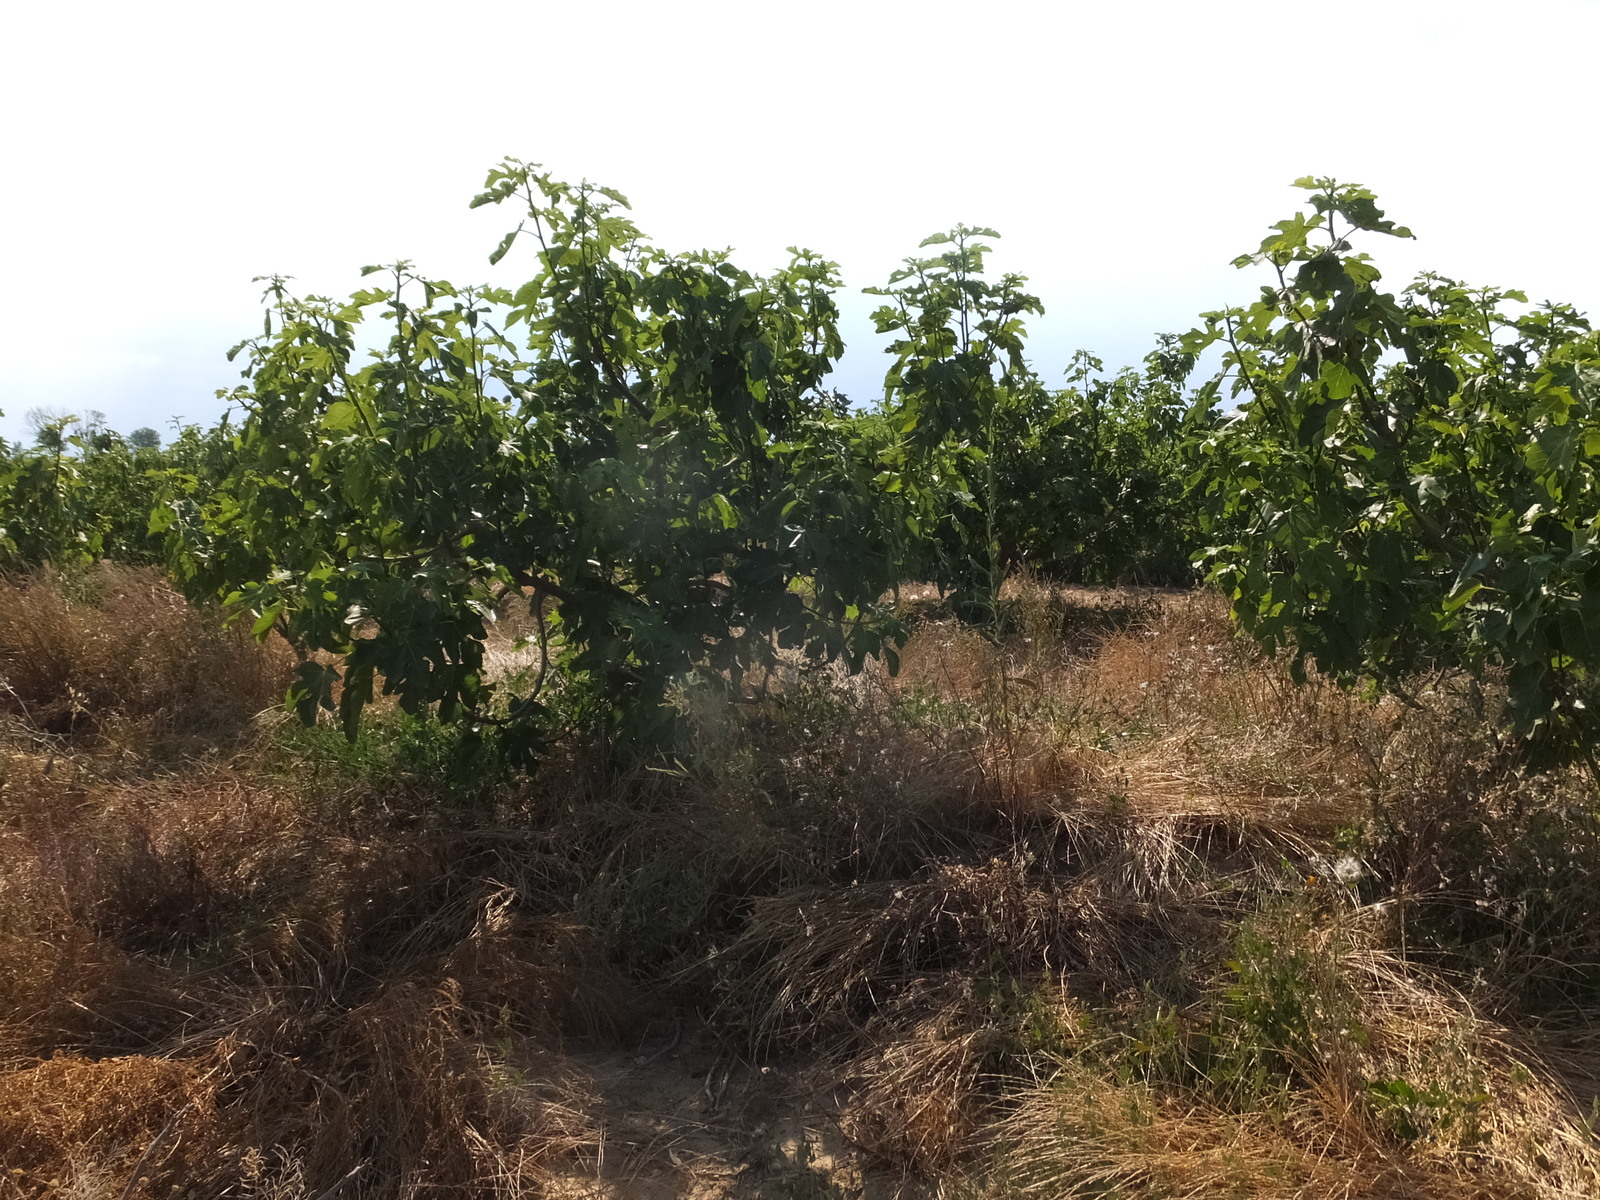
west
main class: Cropland
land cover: Other fruit trees and berries
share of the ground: > 75 %
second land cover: Spontaneously vegetated surfaces
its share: 10 - 25 %
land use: Agriculture (excluding fallow land and kitchen gardens)
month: June
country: ES
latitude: 41.7996
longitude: 0.0543
